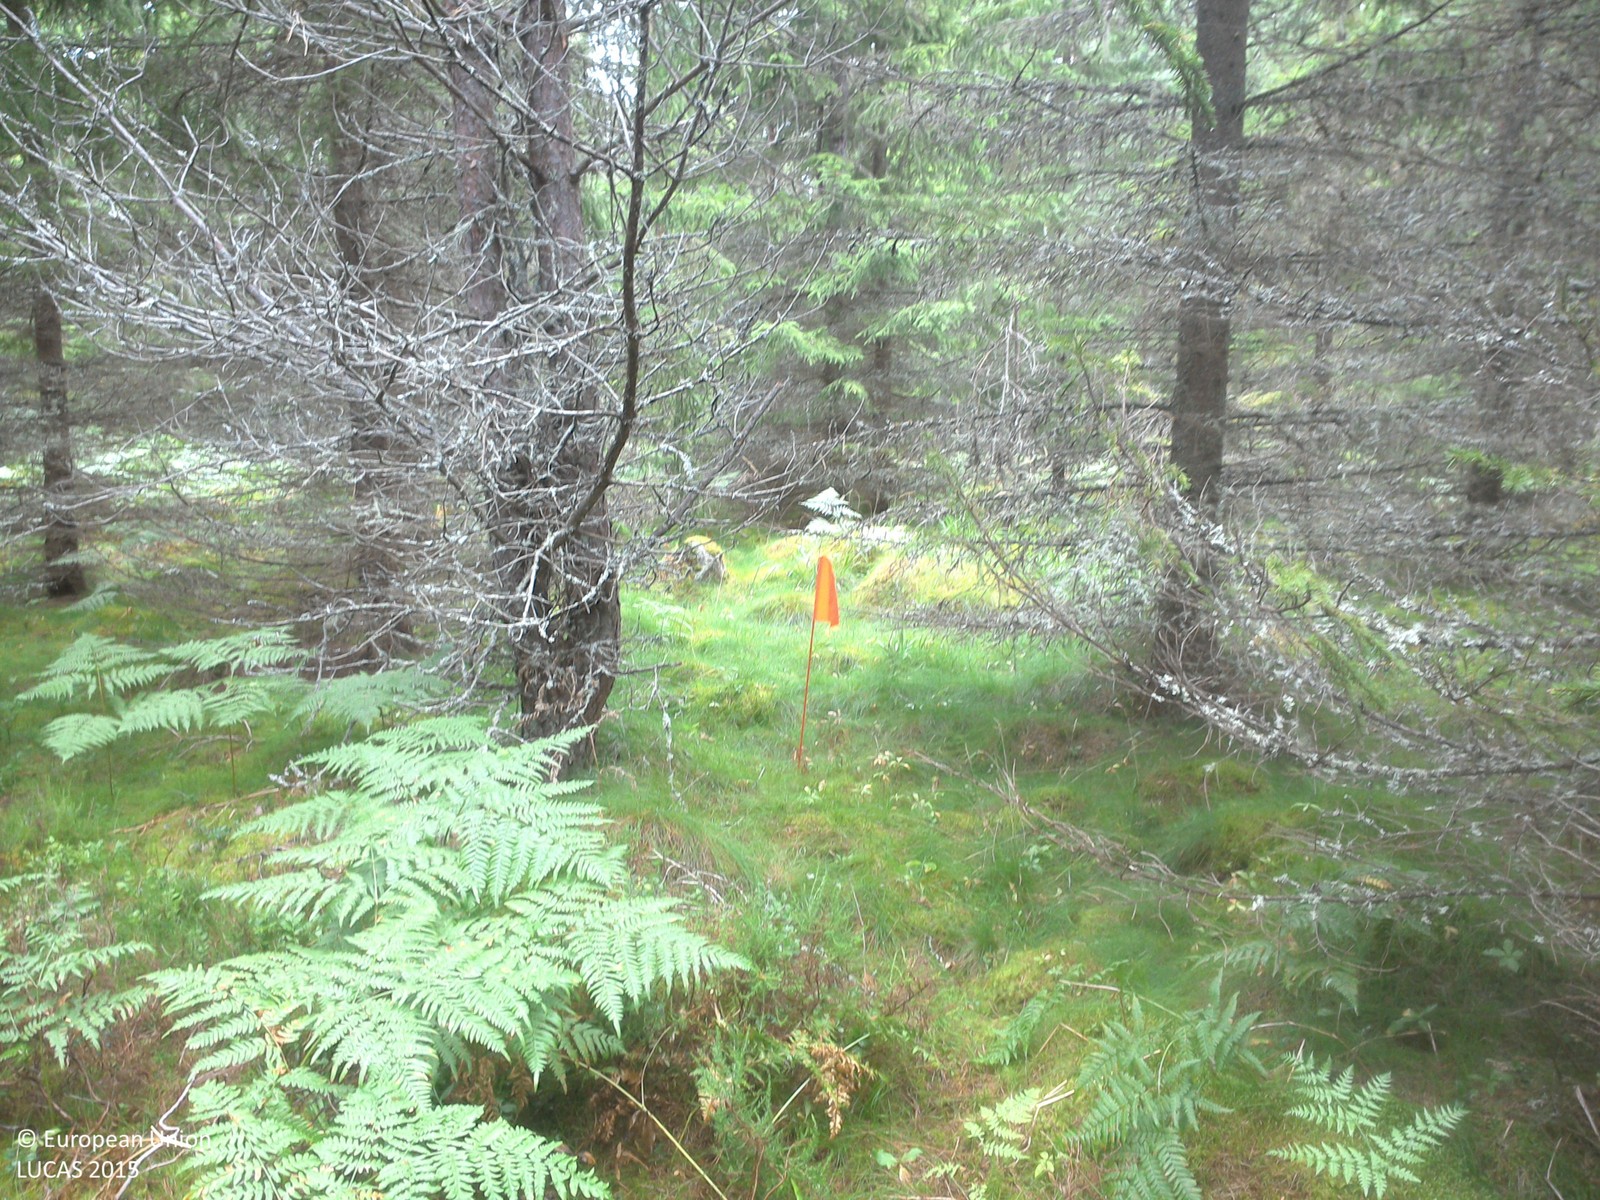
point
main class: Woodland
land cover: Spruce dominated coniferous woodland
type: boreal forest
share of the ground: > 75 %
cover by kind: coniferous forest trees 80 %, shrubs 10 %, lichens and mosses 10 %
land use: Forestry
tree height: > 5 m
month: August
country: SE
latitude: 57.7661
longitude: 15.4592
